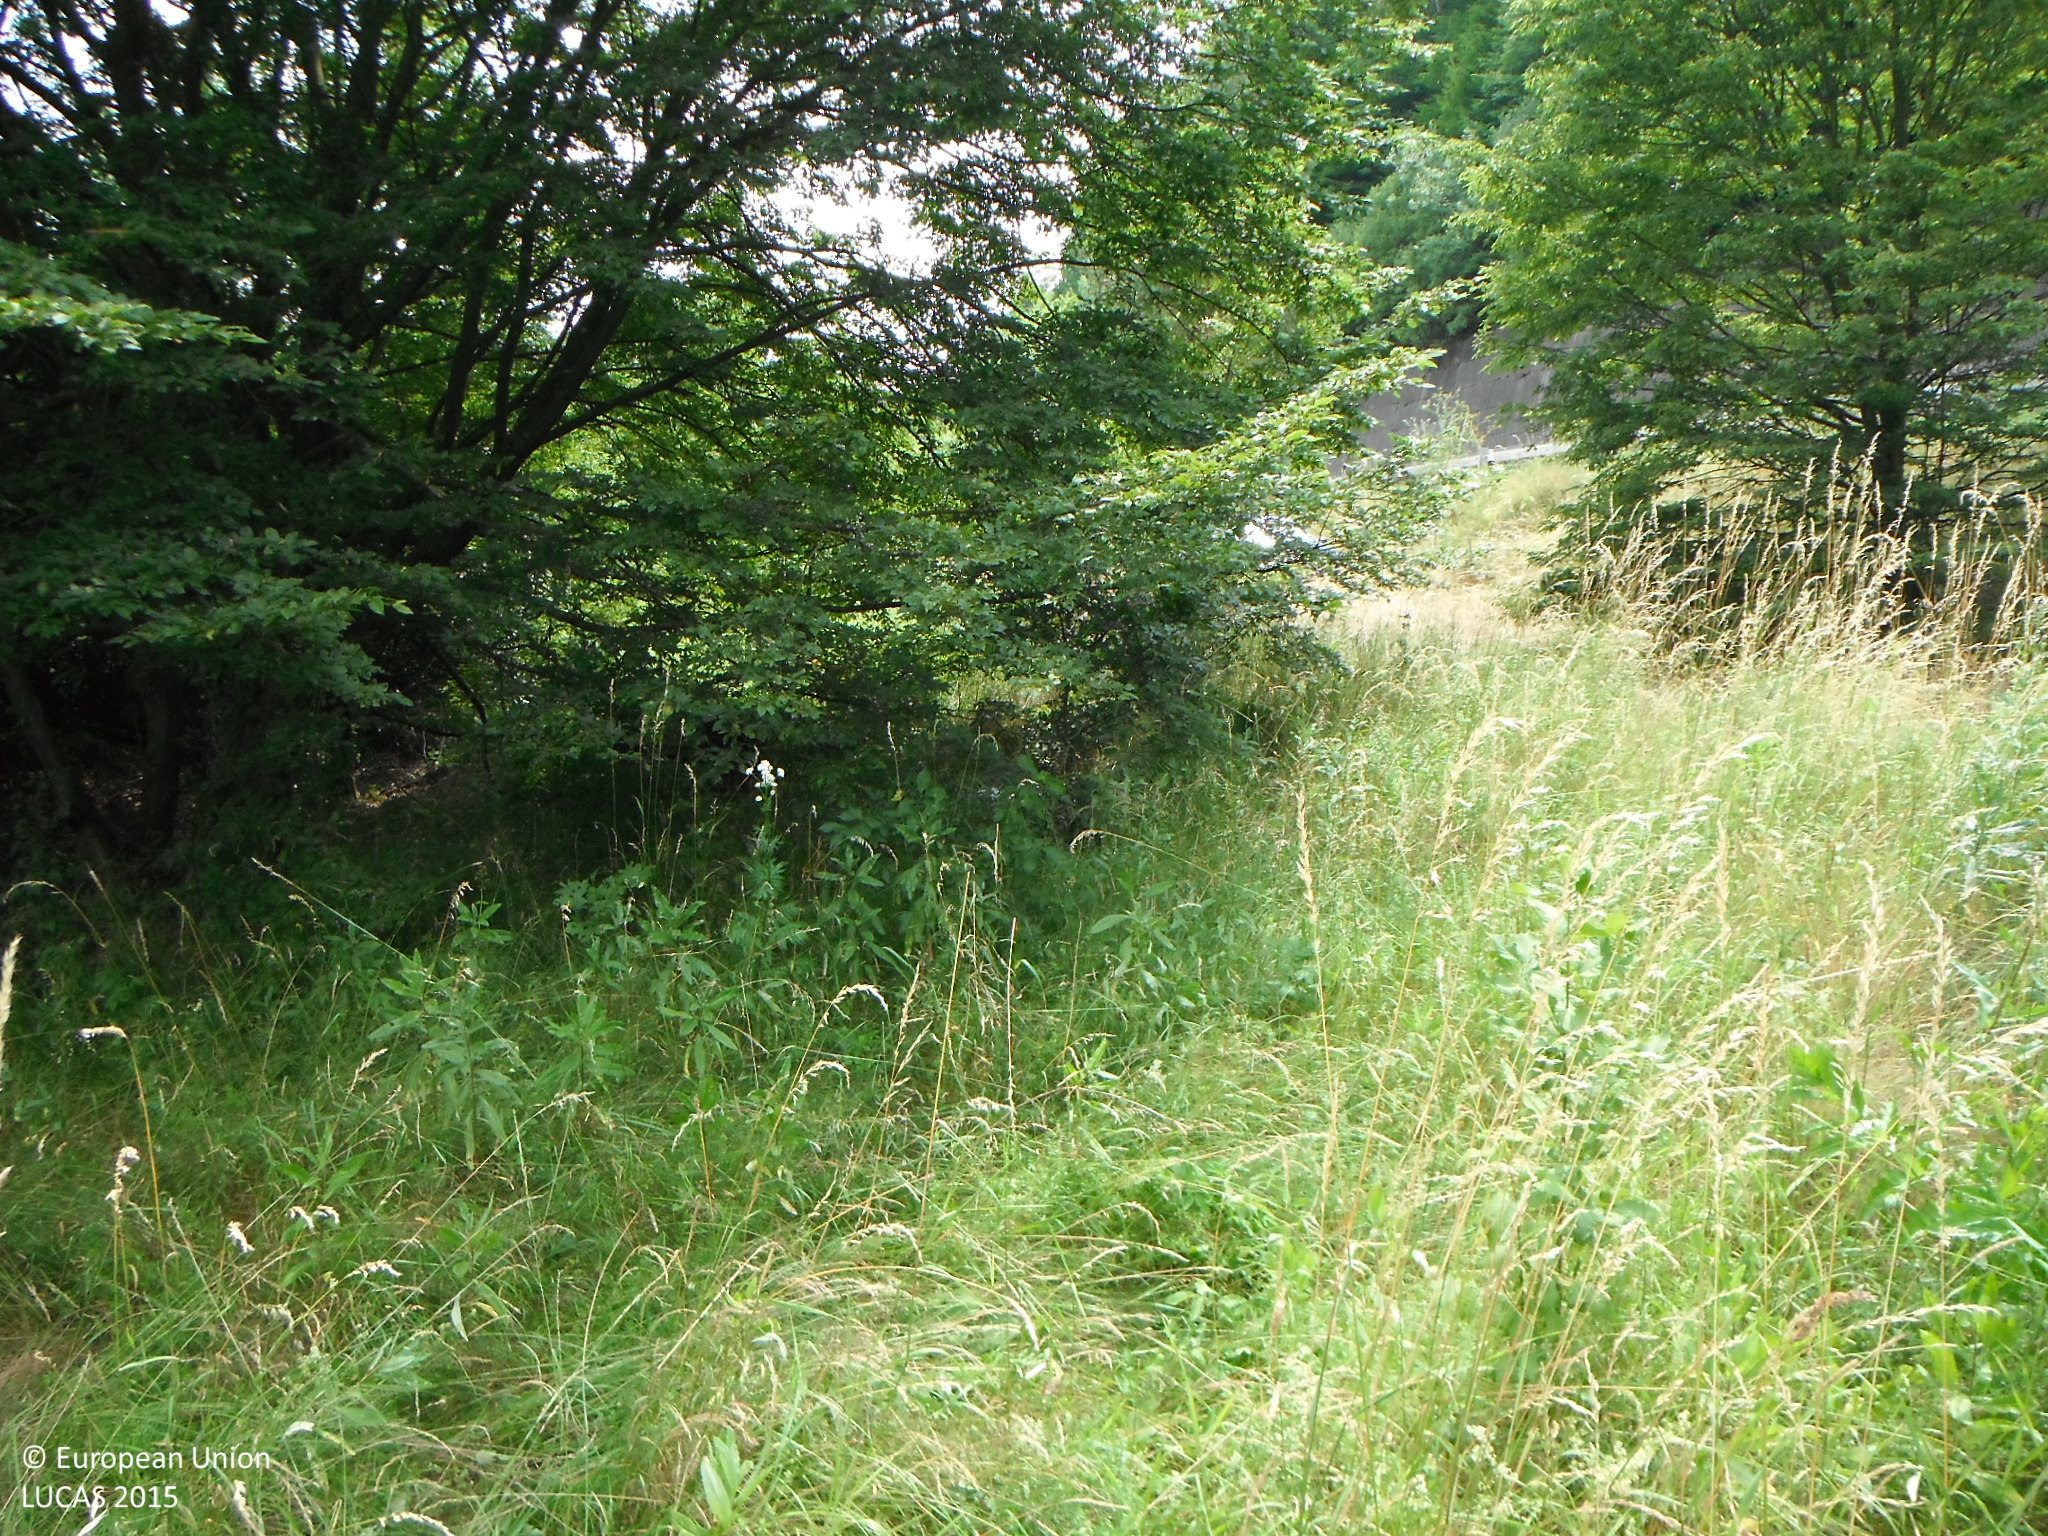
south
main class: Grassland
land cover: Grassland with sparse tree/shrub cover
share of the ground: > 75 %
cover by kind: herbaceous plants 90 %, broadleaved forest trees 5 %, shrubs 5 %
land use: Semi-natural and natural areas not in use
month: July
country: SK
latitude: 48.4090
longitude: 19.0860
